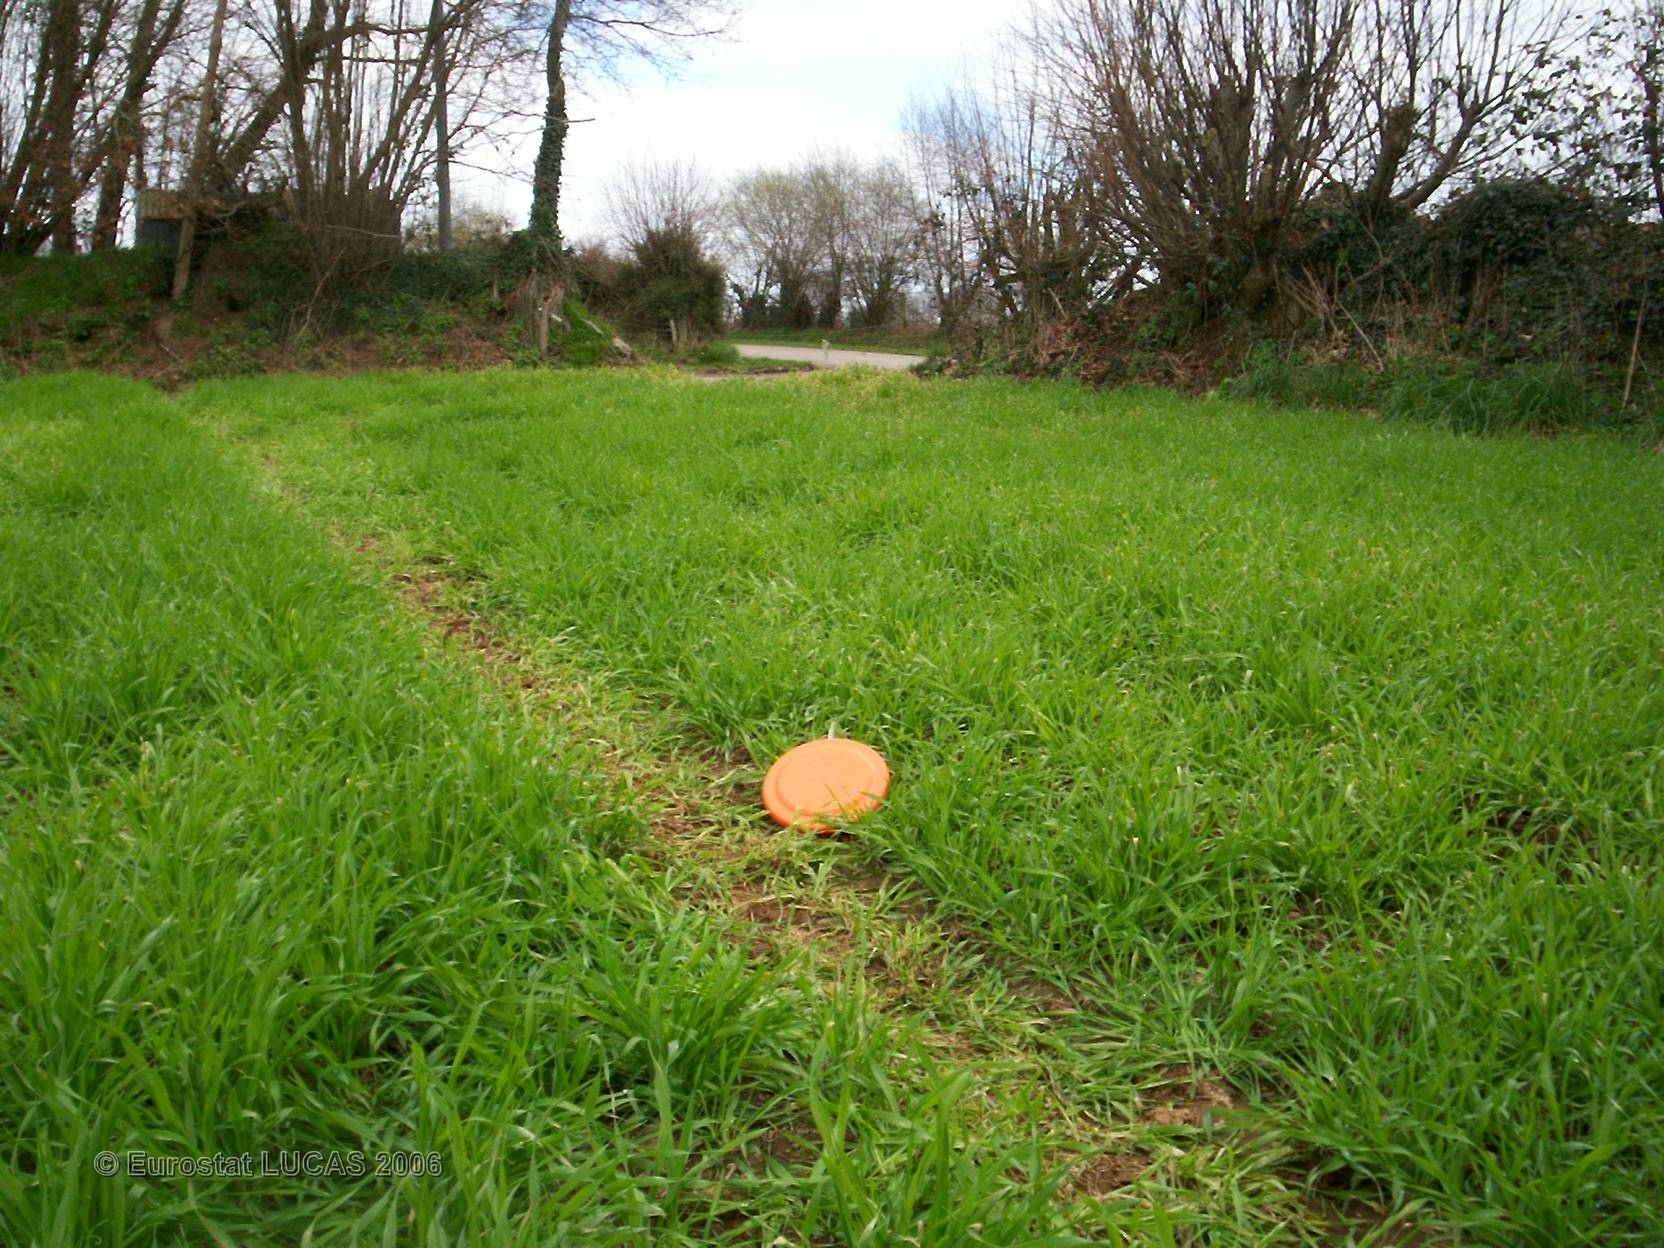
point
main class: Cropland
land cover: Barley
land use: Agriculture (excluding fallow land and kitchen gardens)
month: April
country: FR
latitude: 48.1053
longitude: -3.6030
